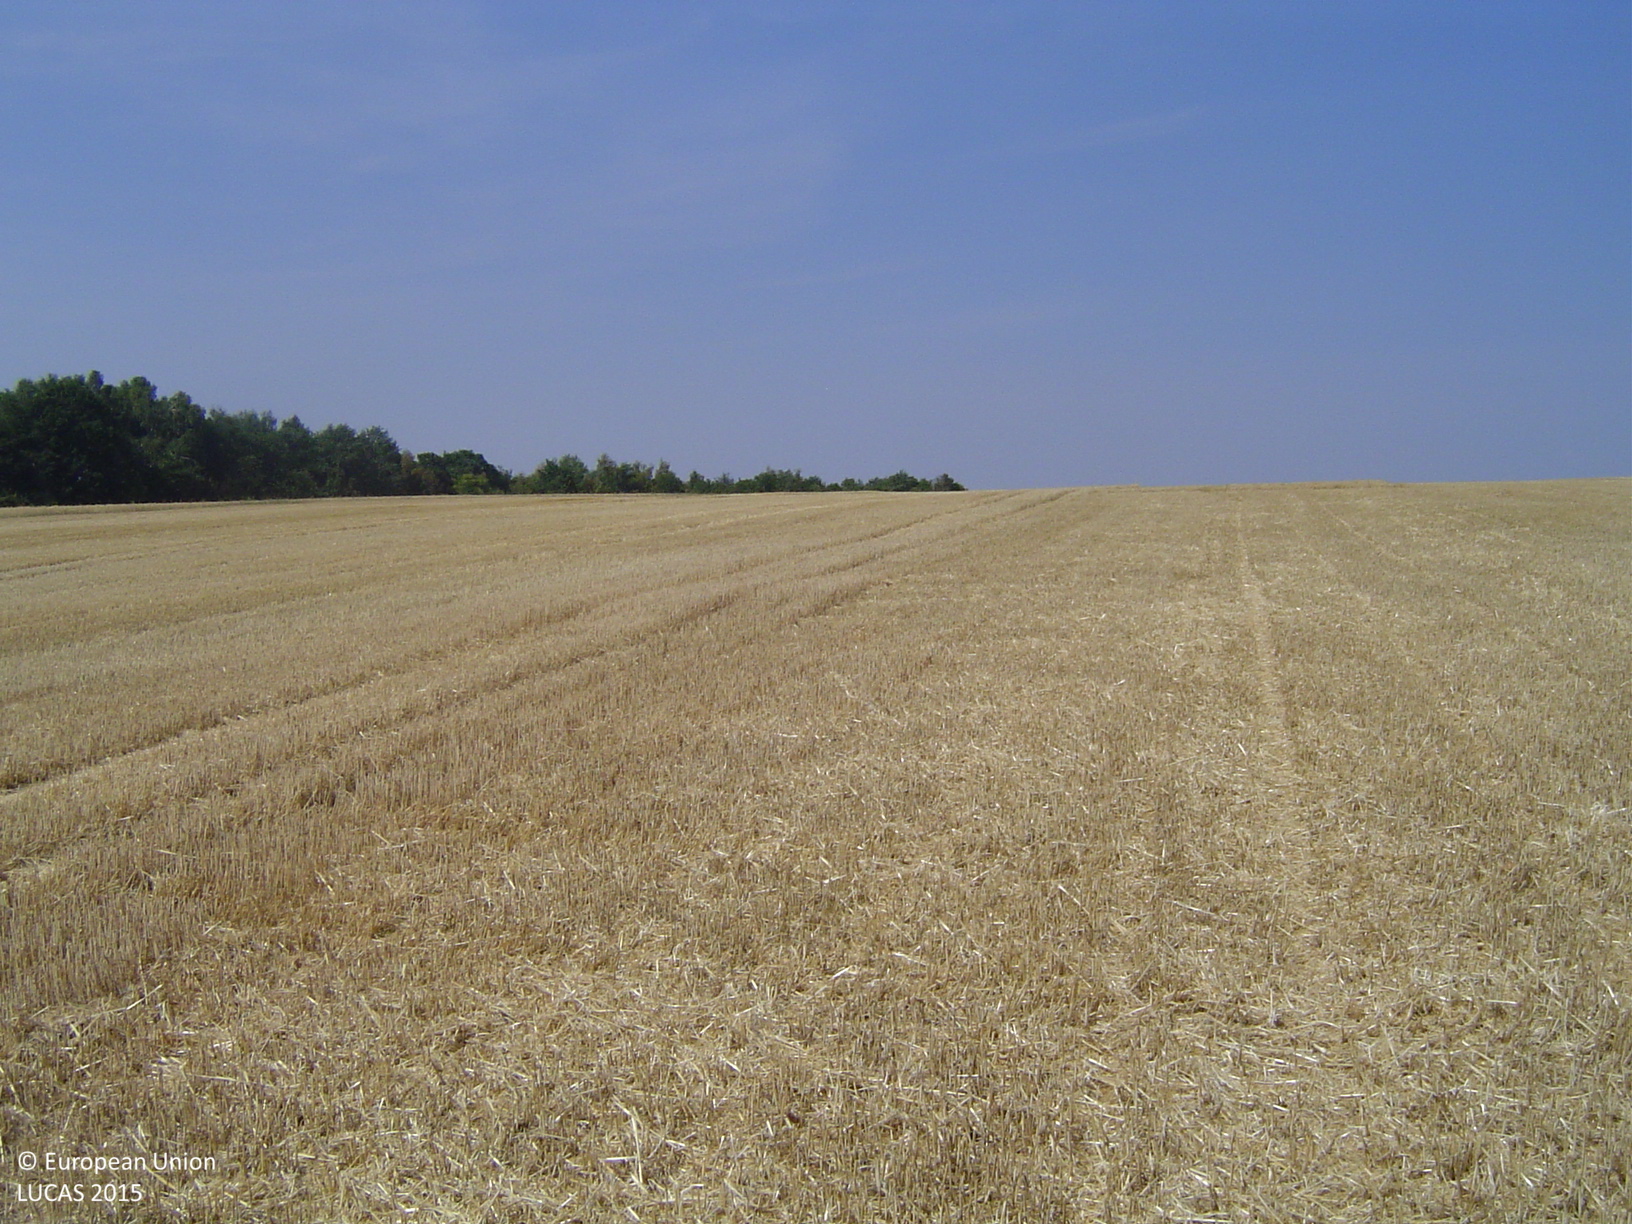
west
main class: Cropland
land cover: Barley
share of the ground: > 75 %
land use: Agriculture (excluding fallow land and kitchen gardens)
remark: Harvested field
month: August
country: CZ
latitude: 50.1921
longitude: 13.8247
